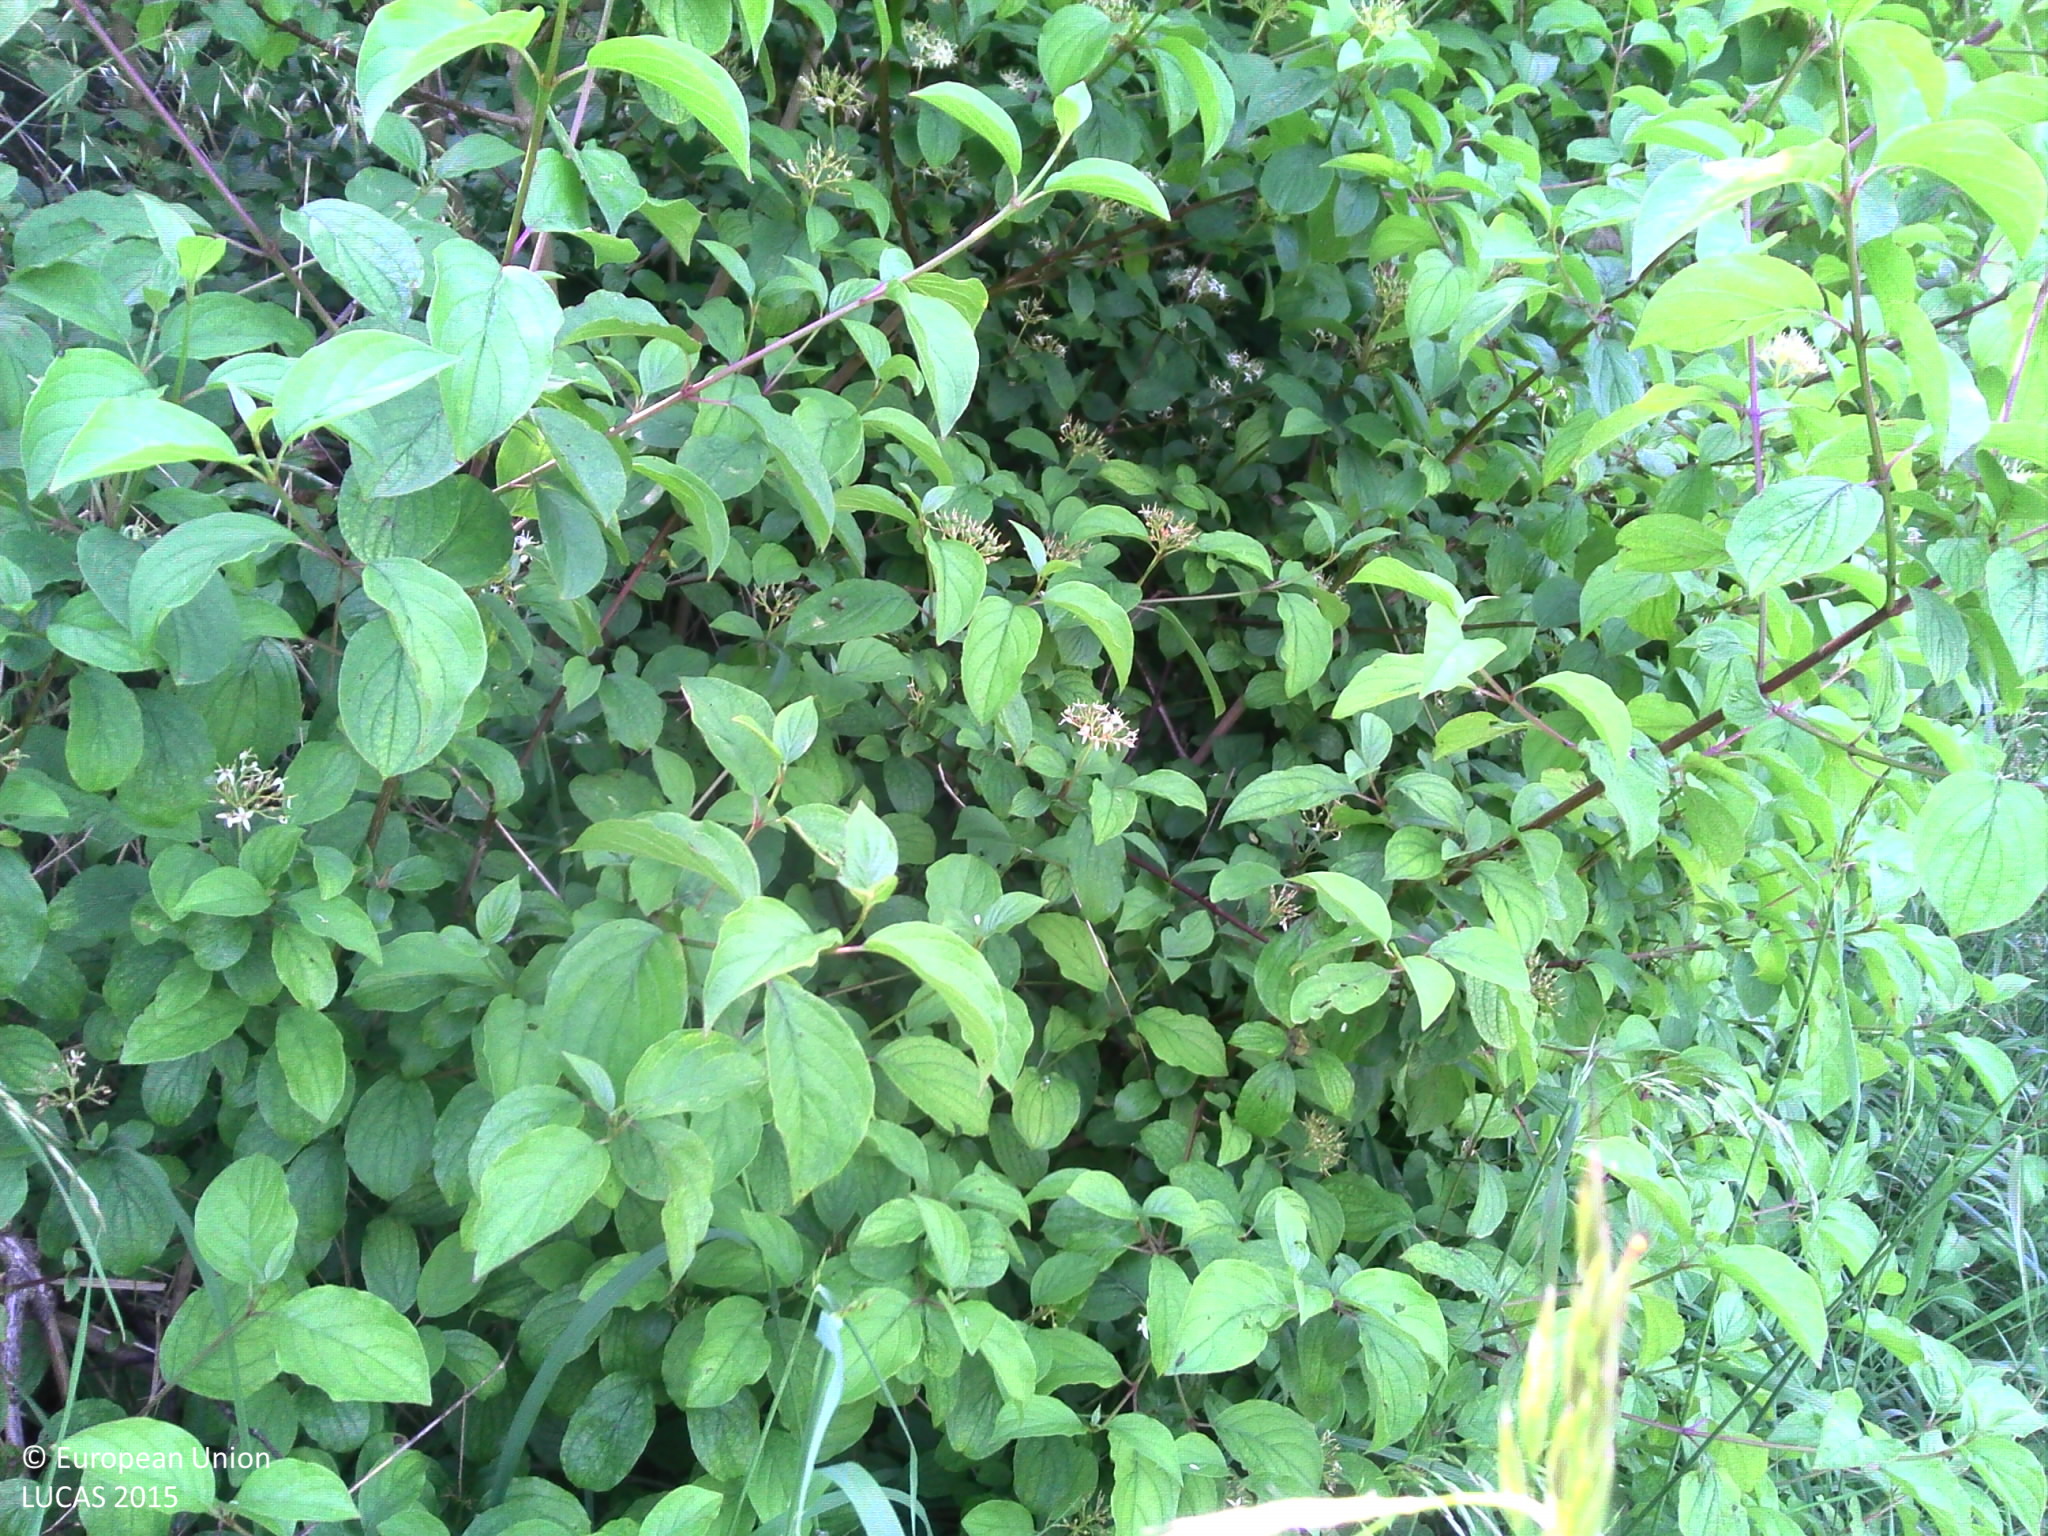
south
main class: Woodland
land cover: Broadleaved woodland
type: non-riverine alder, birch or aspen forest
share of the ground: > 75 %
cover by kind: broadleaved forest trees 80 %, shrubs 10 %, herbaceous plants 5 %, lichens and mosses 5 %
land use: Forestry
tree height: > 5 m
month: June
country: FR
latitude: 49.7193
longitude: 2.4839
